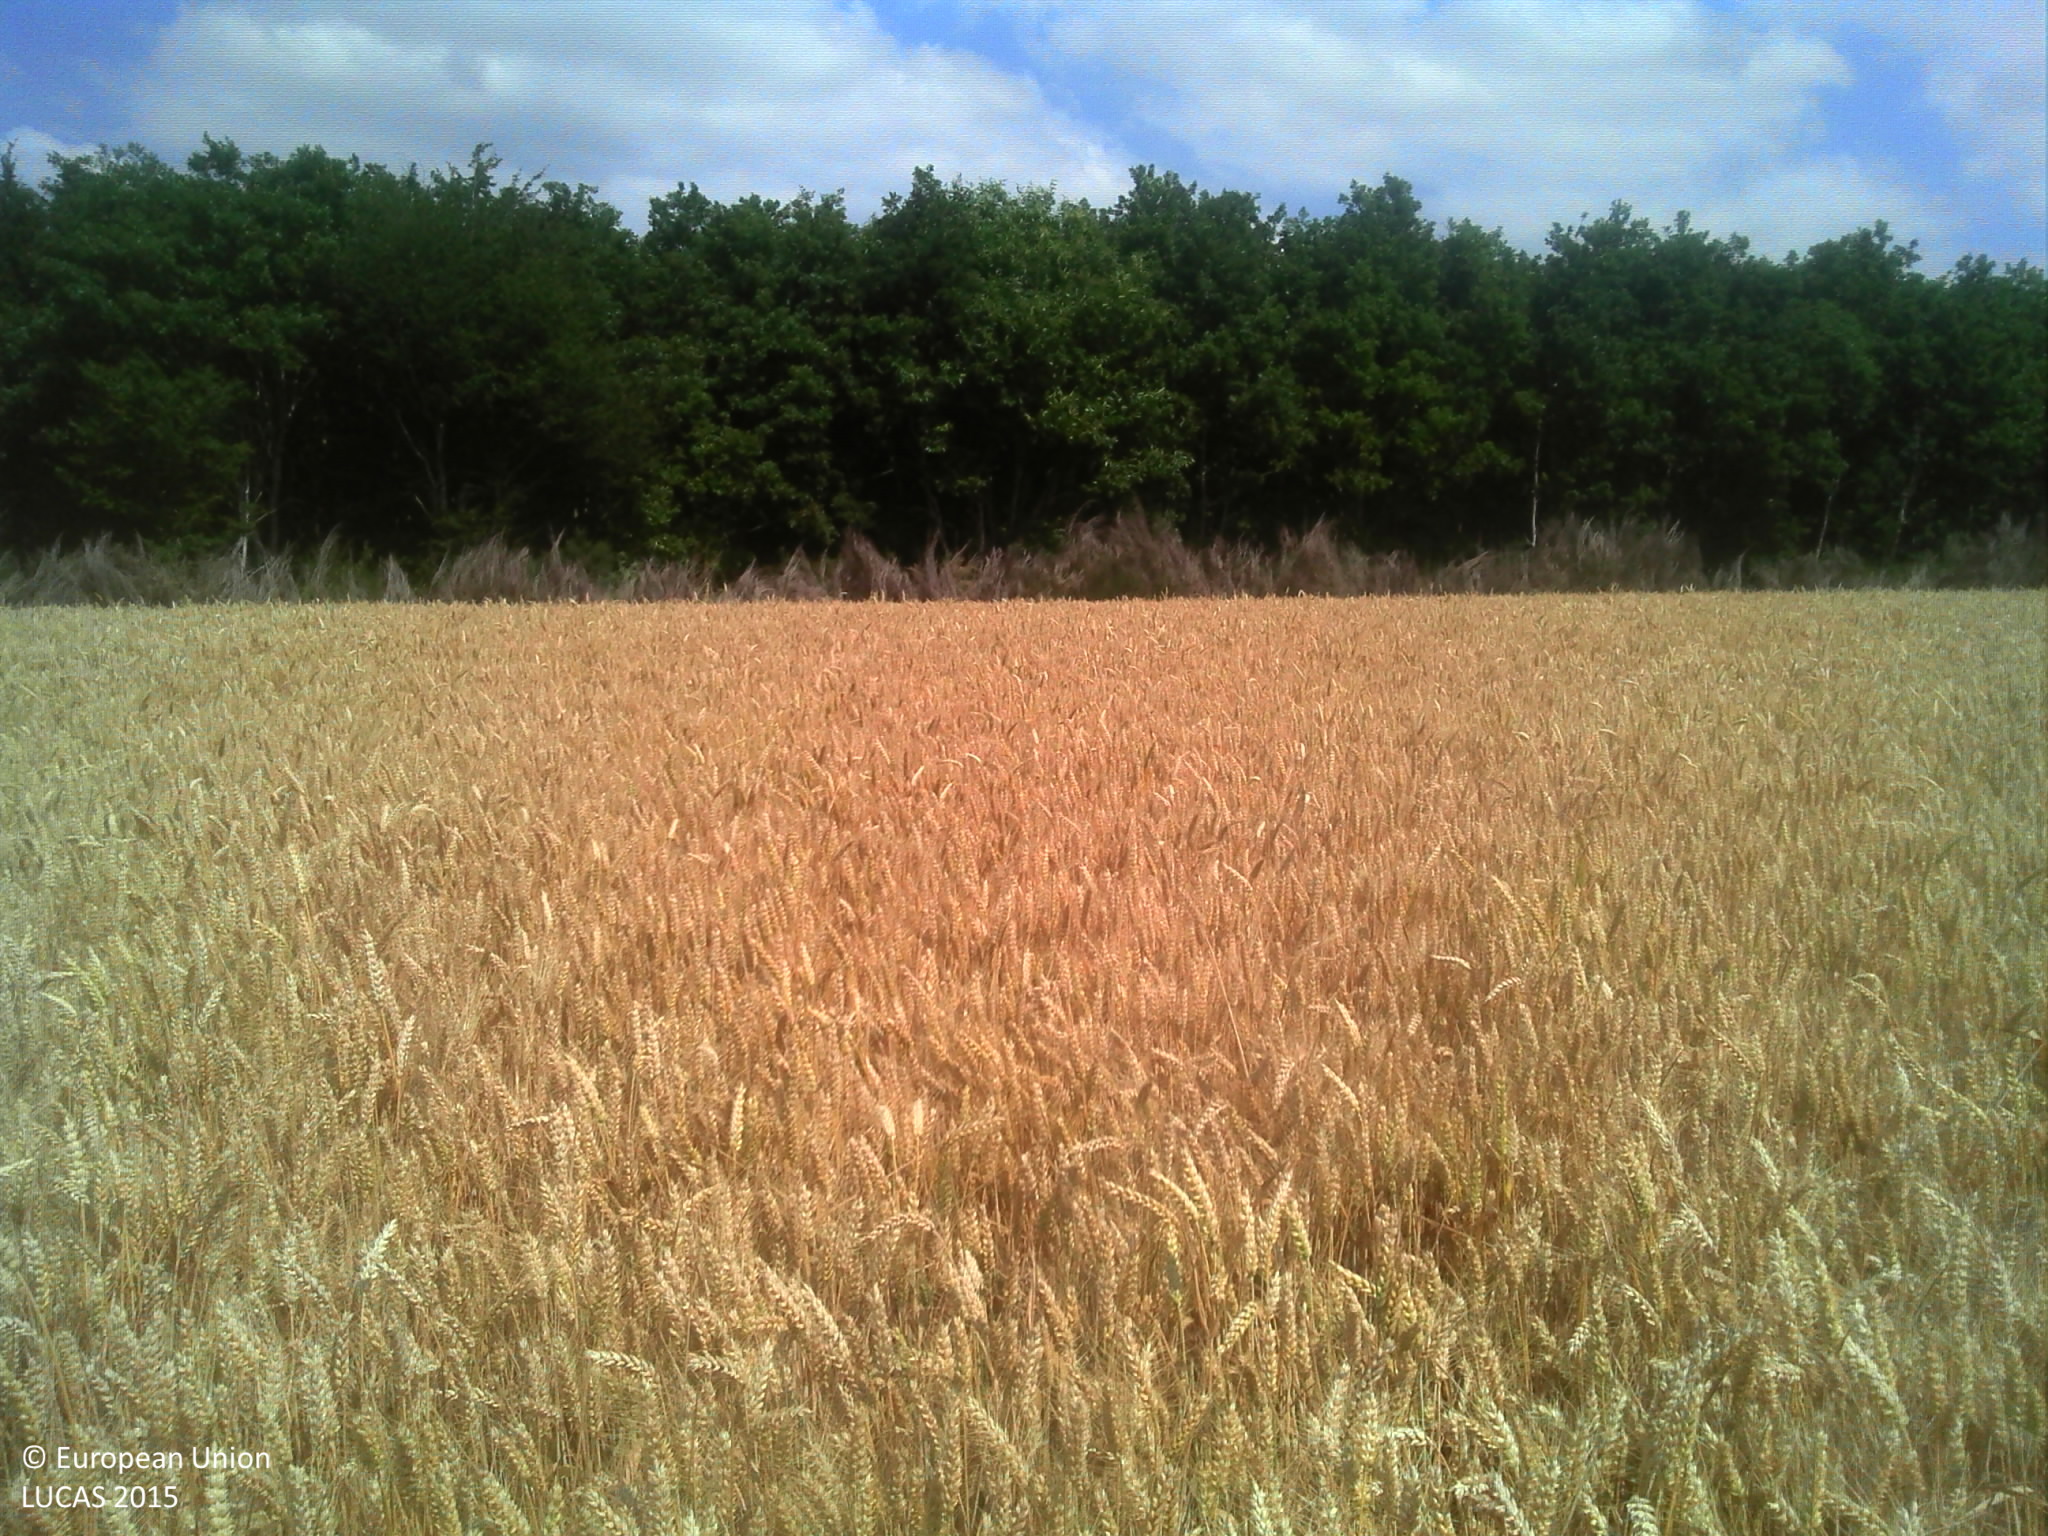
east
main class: Cropland
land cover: Common wheat
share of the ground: > 75 %
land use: Agriculture (excluding fallow land and kitchen gardens)
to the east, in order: Common wheat; Spontaneously vegetated surfaces; Broadleaved woodland; Tracks; Common wheat; Broadleaved woodland; Tracks
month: July
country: FR
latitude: 48.7563
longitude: 1.1795
